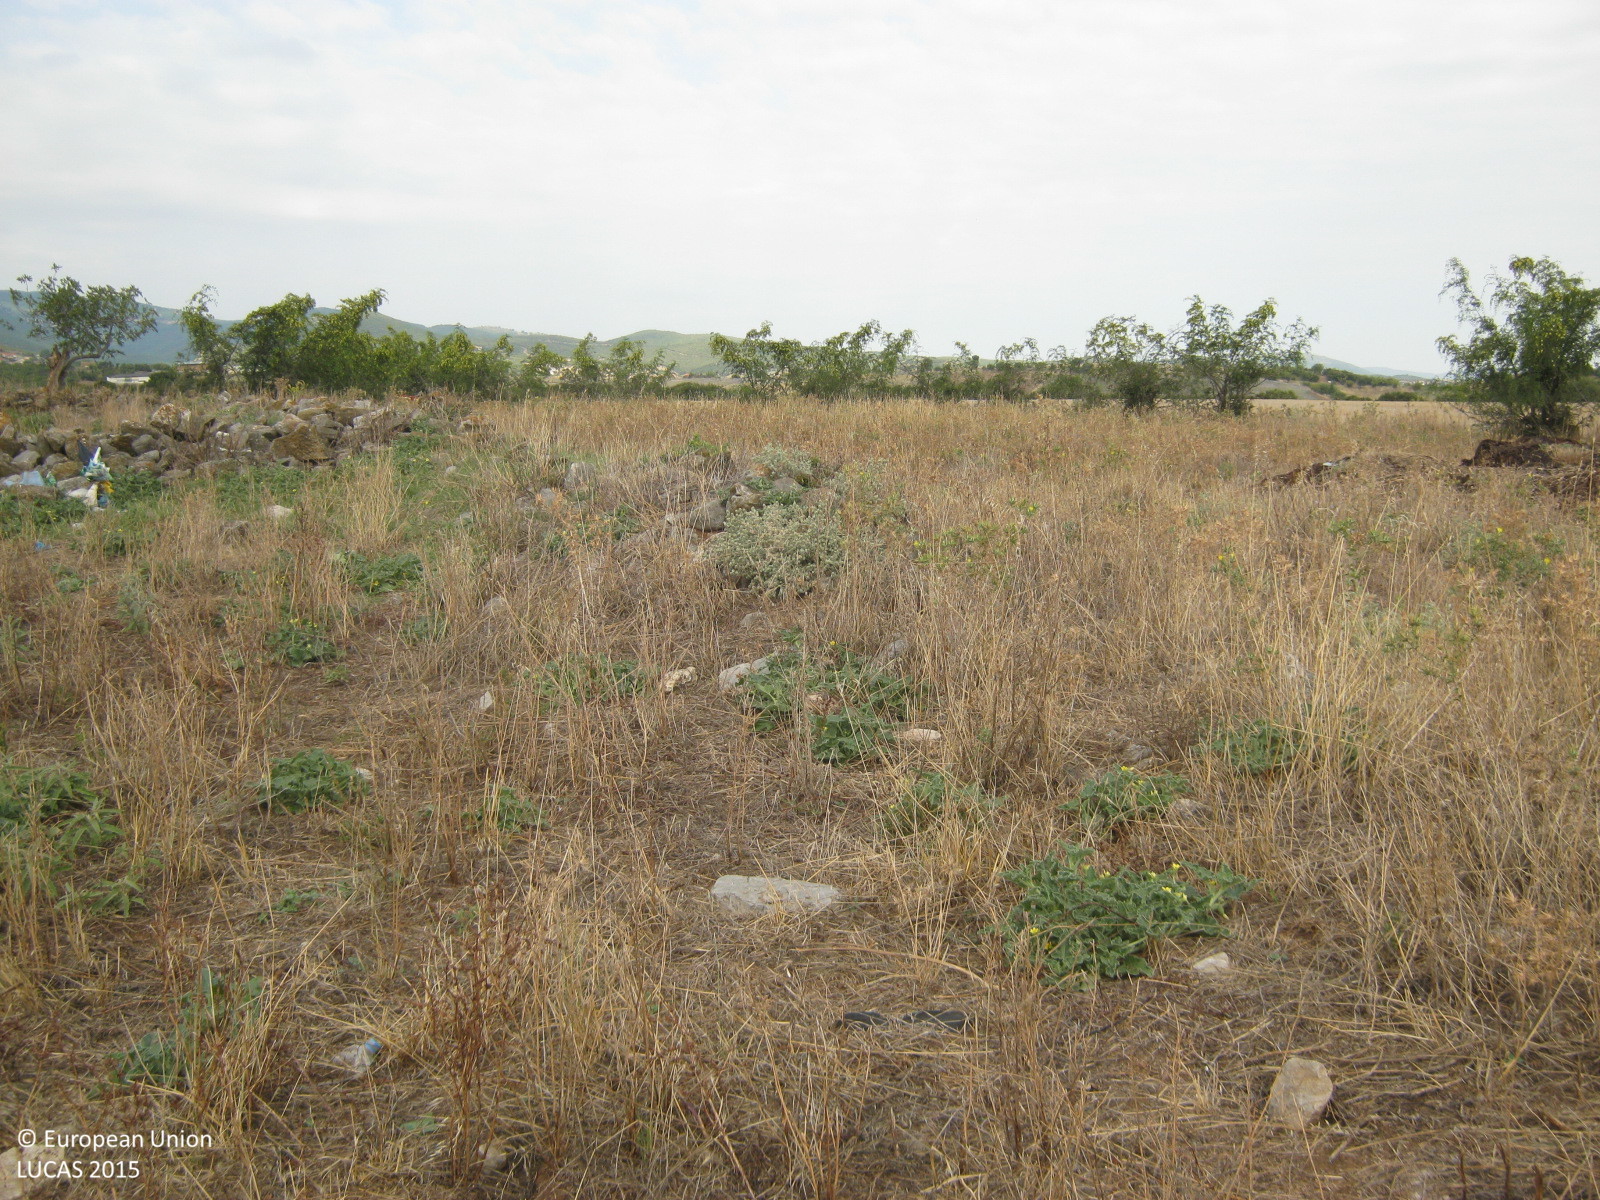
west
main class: Grassland
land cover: Grassland without tree/shrub cover
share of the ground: > 75 %
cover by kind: herbaceous plants 100 %
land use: Agriculture (excluding fallow land and kitchen gardens)
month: July
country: GR
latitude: 39.1722
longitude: 22.6372
